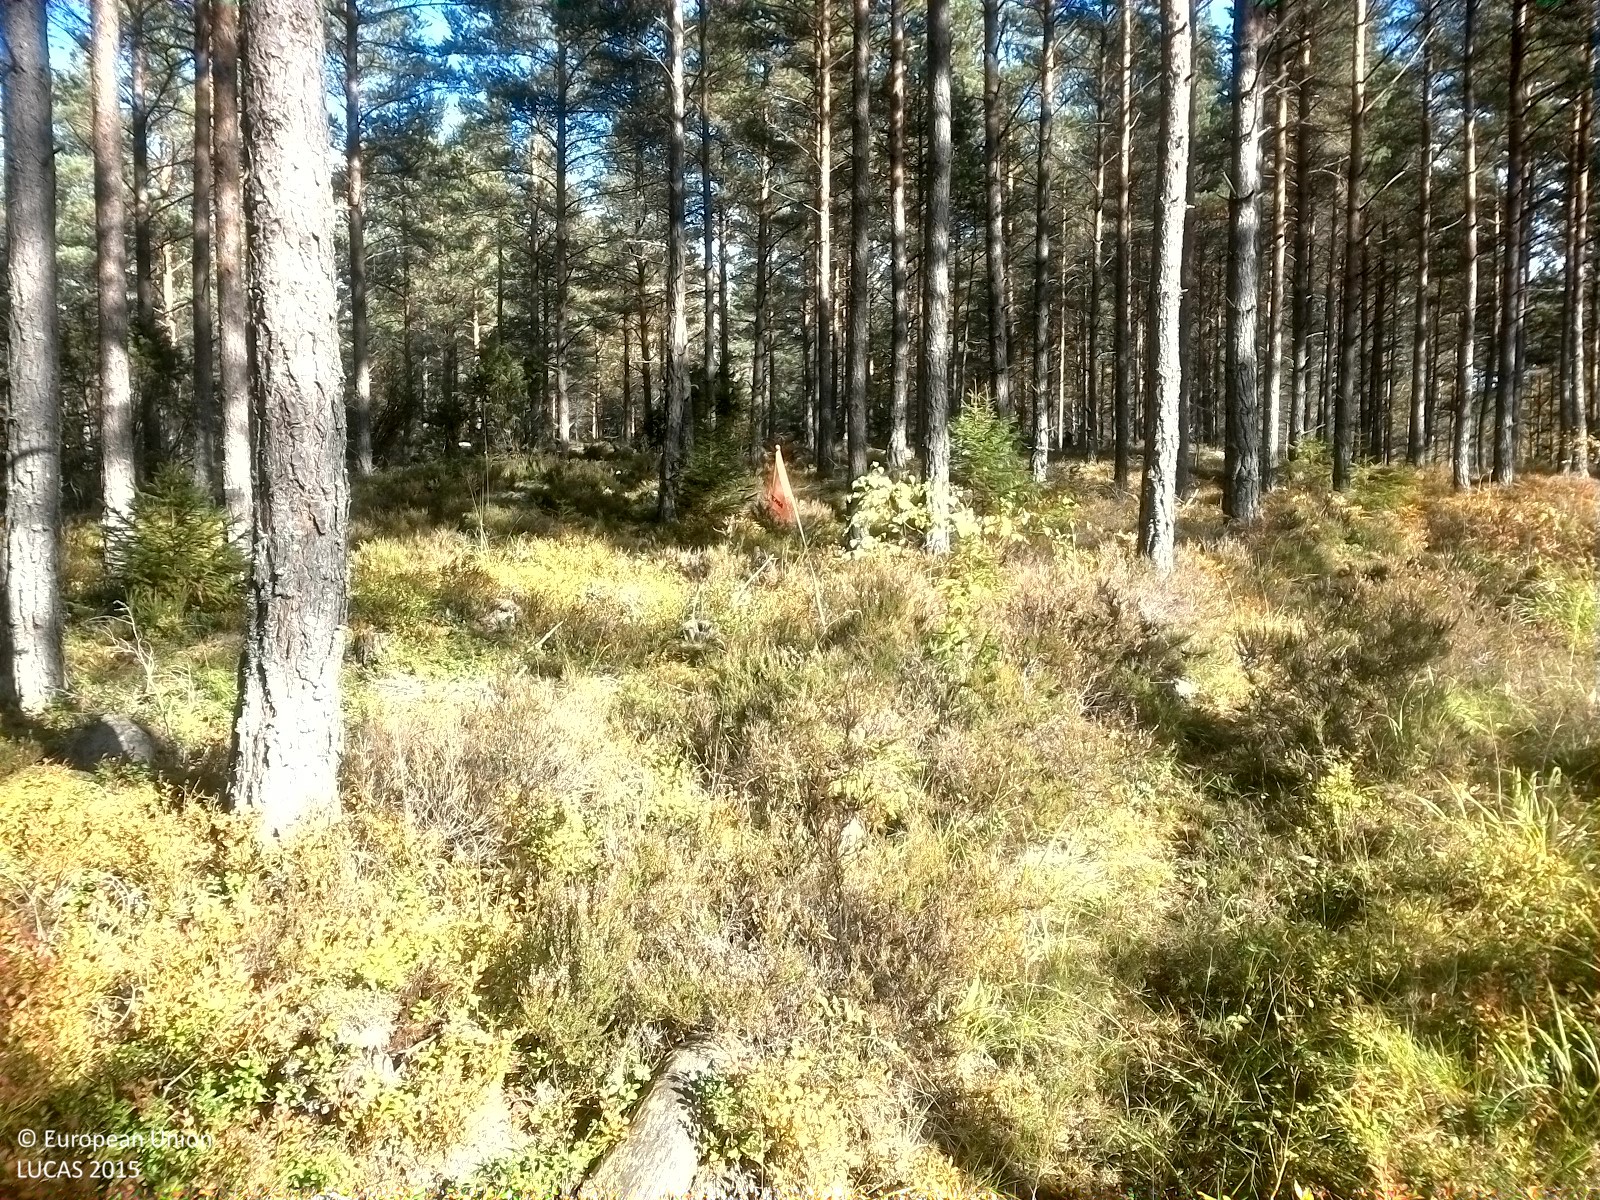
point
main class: Woodland
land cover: Pine dominated coniferous woodland
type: boreal forest
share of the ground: 25 - 50 %
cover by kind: herbaceous plants 40 %, coniferous forest trees 30 %, shrubs 15 %, lichens and mosses 10 %, broadleaved forest trees 5 %
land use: Forestry
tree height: > 5 m
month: September
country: SE
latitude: 58.6450
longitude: 16.7679
